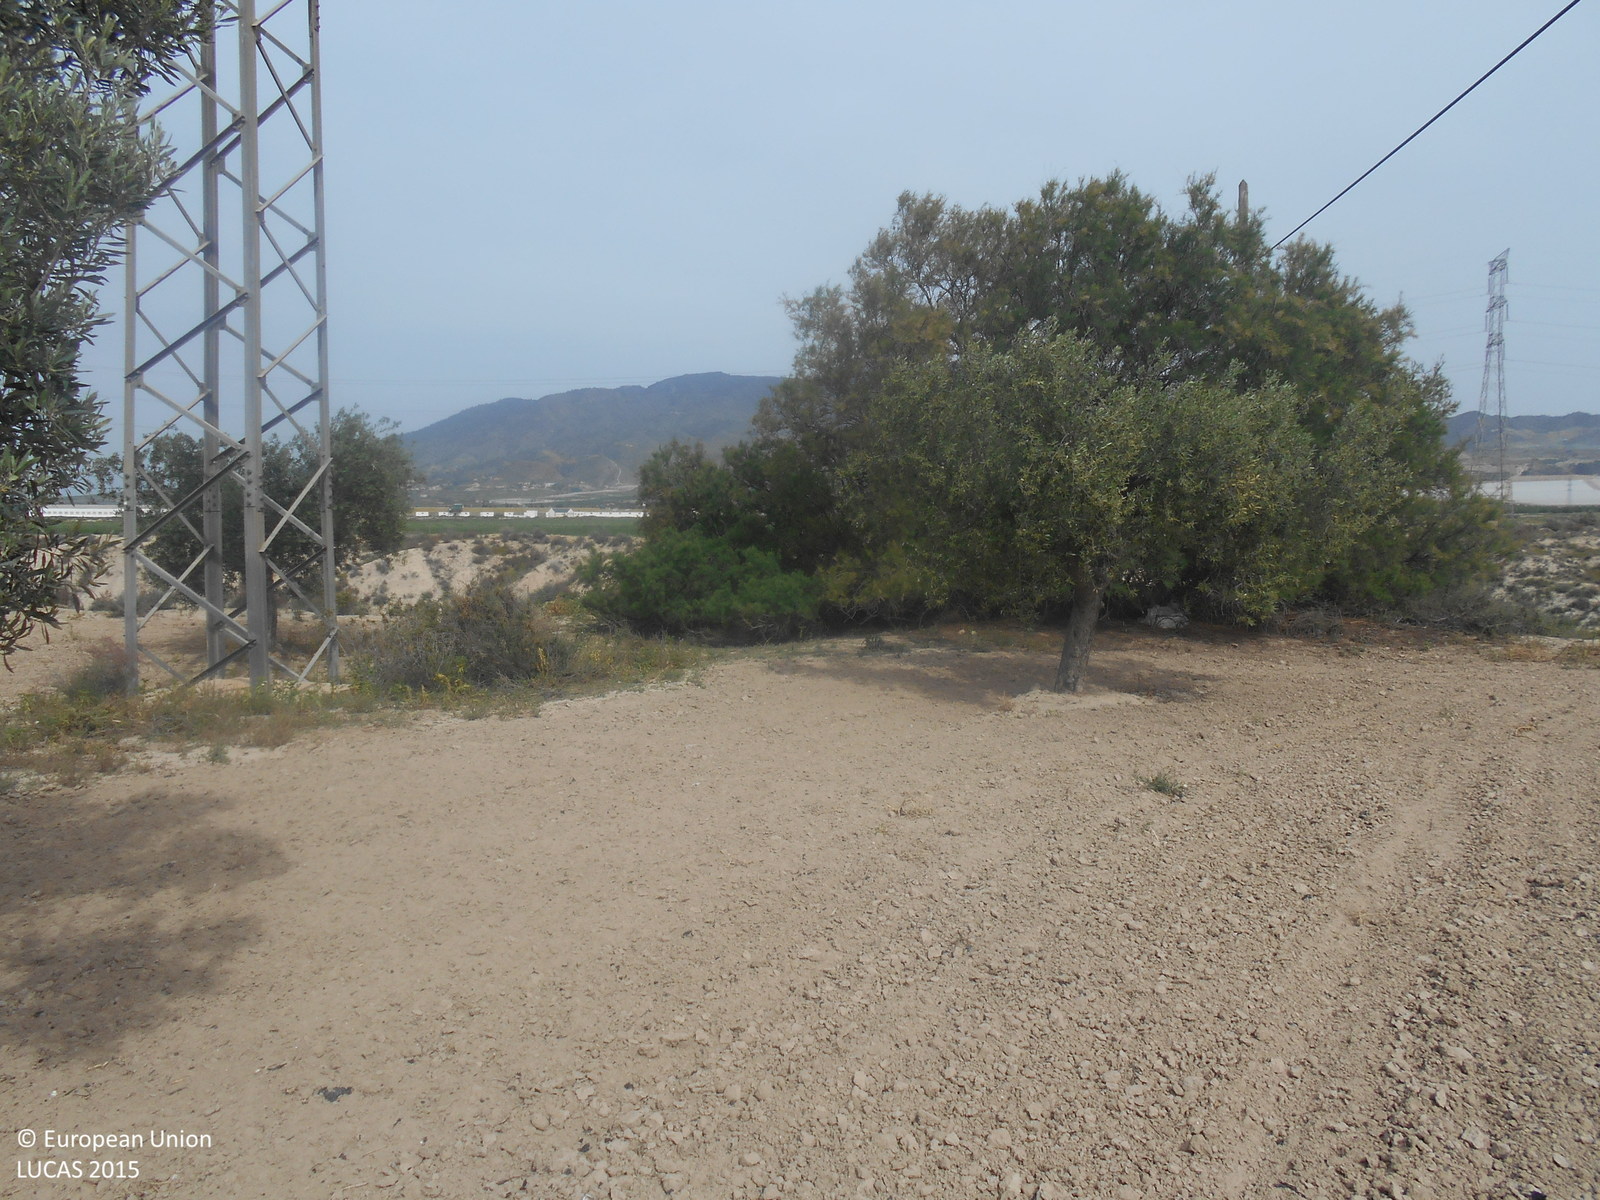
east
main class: Cropland
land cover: Olive groves
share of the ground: > 75 %
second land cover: Other bare soil
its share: > 75 %
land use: Agriculture (excluding fallow land and kitchen gardens)
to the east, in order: Olive groves; Other bare soil; Olive groves; Electric lines; Shrubland without tree cover; Tracks; Inland fresh running water; Shrubland without tree cover; Olive groves; Artificial constructions in urban areas; Tracks; Olive groves; Shrubland without tree cover; Oats
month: April
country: ES
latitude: 37.8306
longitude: -1.3790
